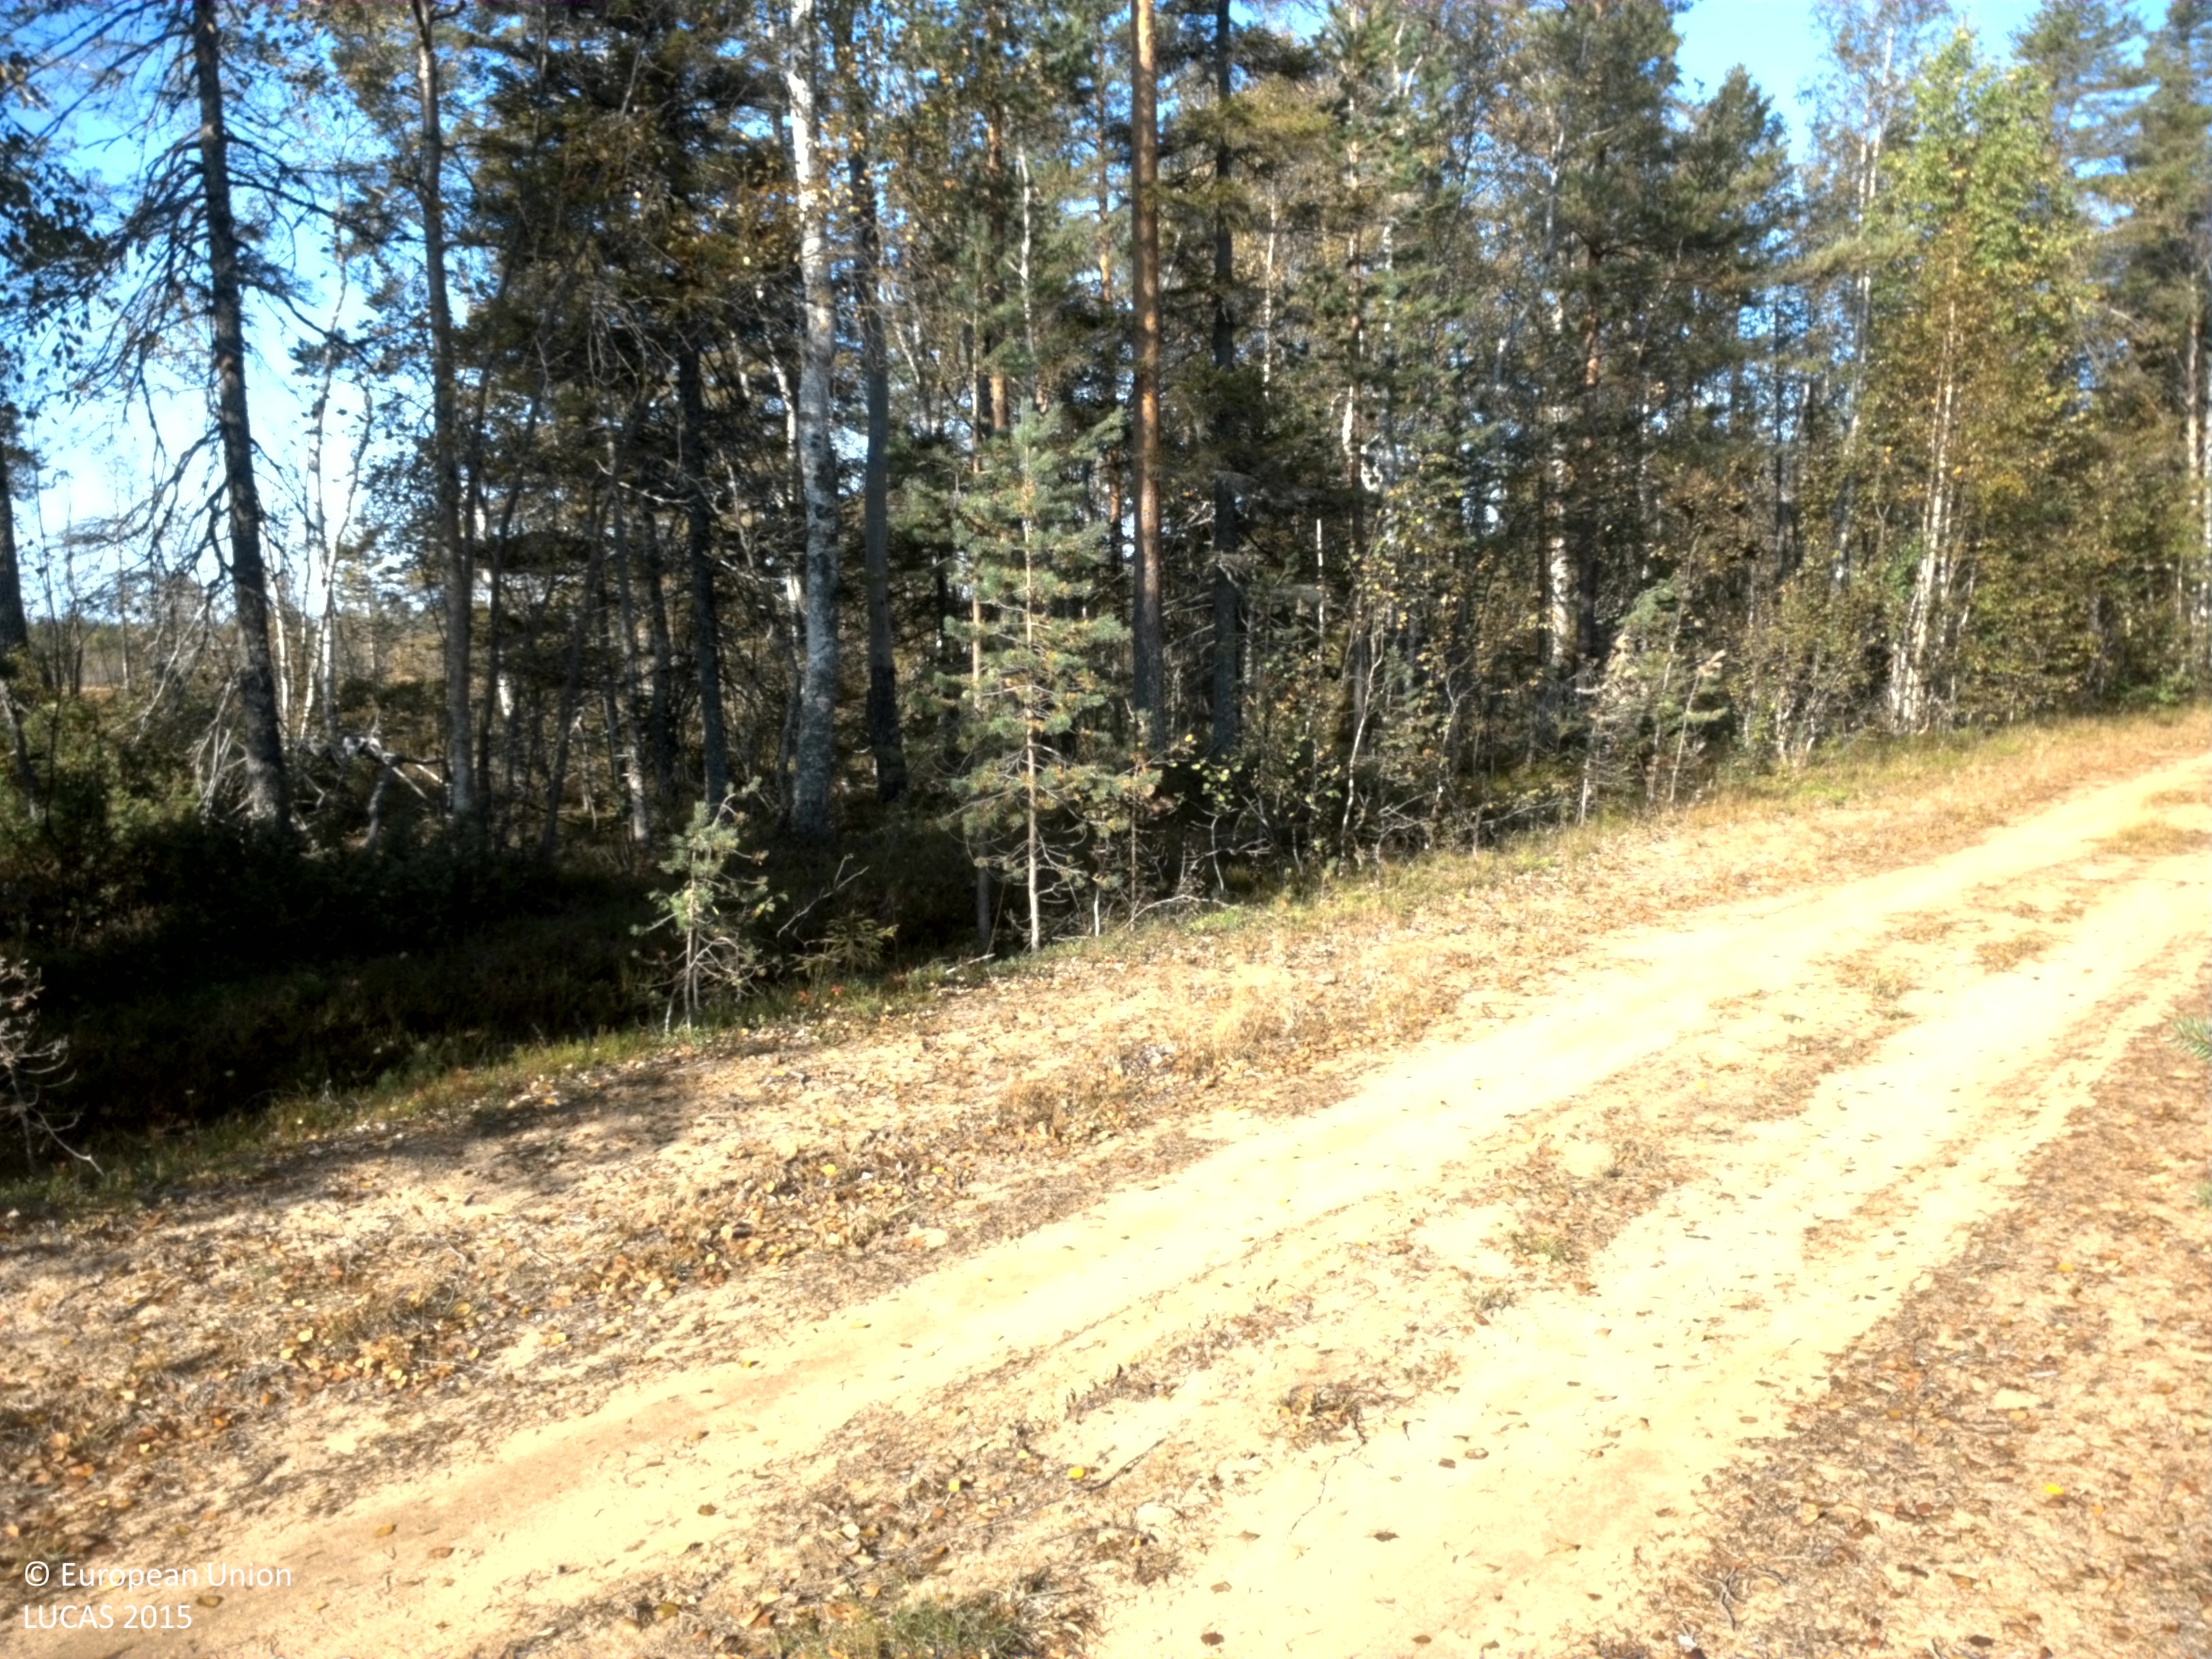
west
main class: Woodland
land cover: Pine dominated mixed woodland
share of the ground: 25 - 50 %
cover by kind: shrubs 60 %, coniferous forest trees 20 %, broadleaved forest trees 20 %
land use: Forestry
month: September
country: SE
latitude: 65.8976
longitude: 22.5548
